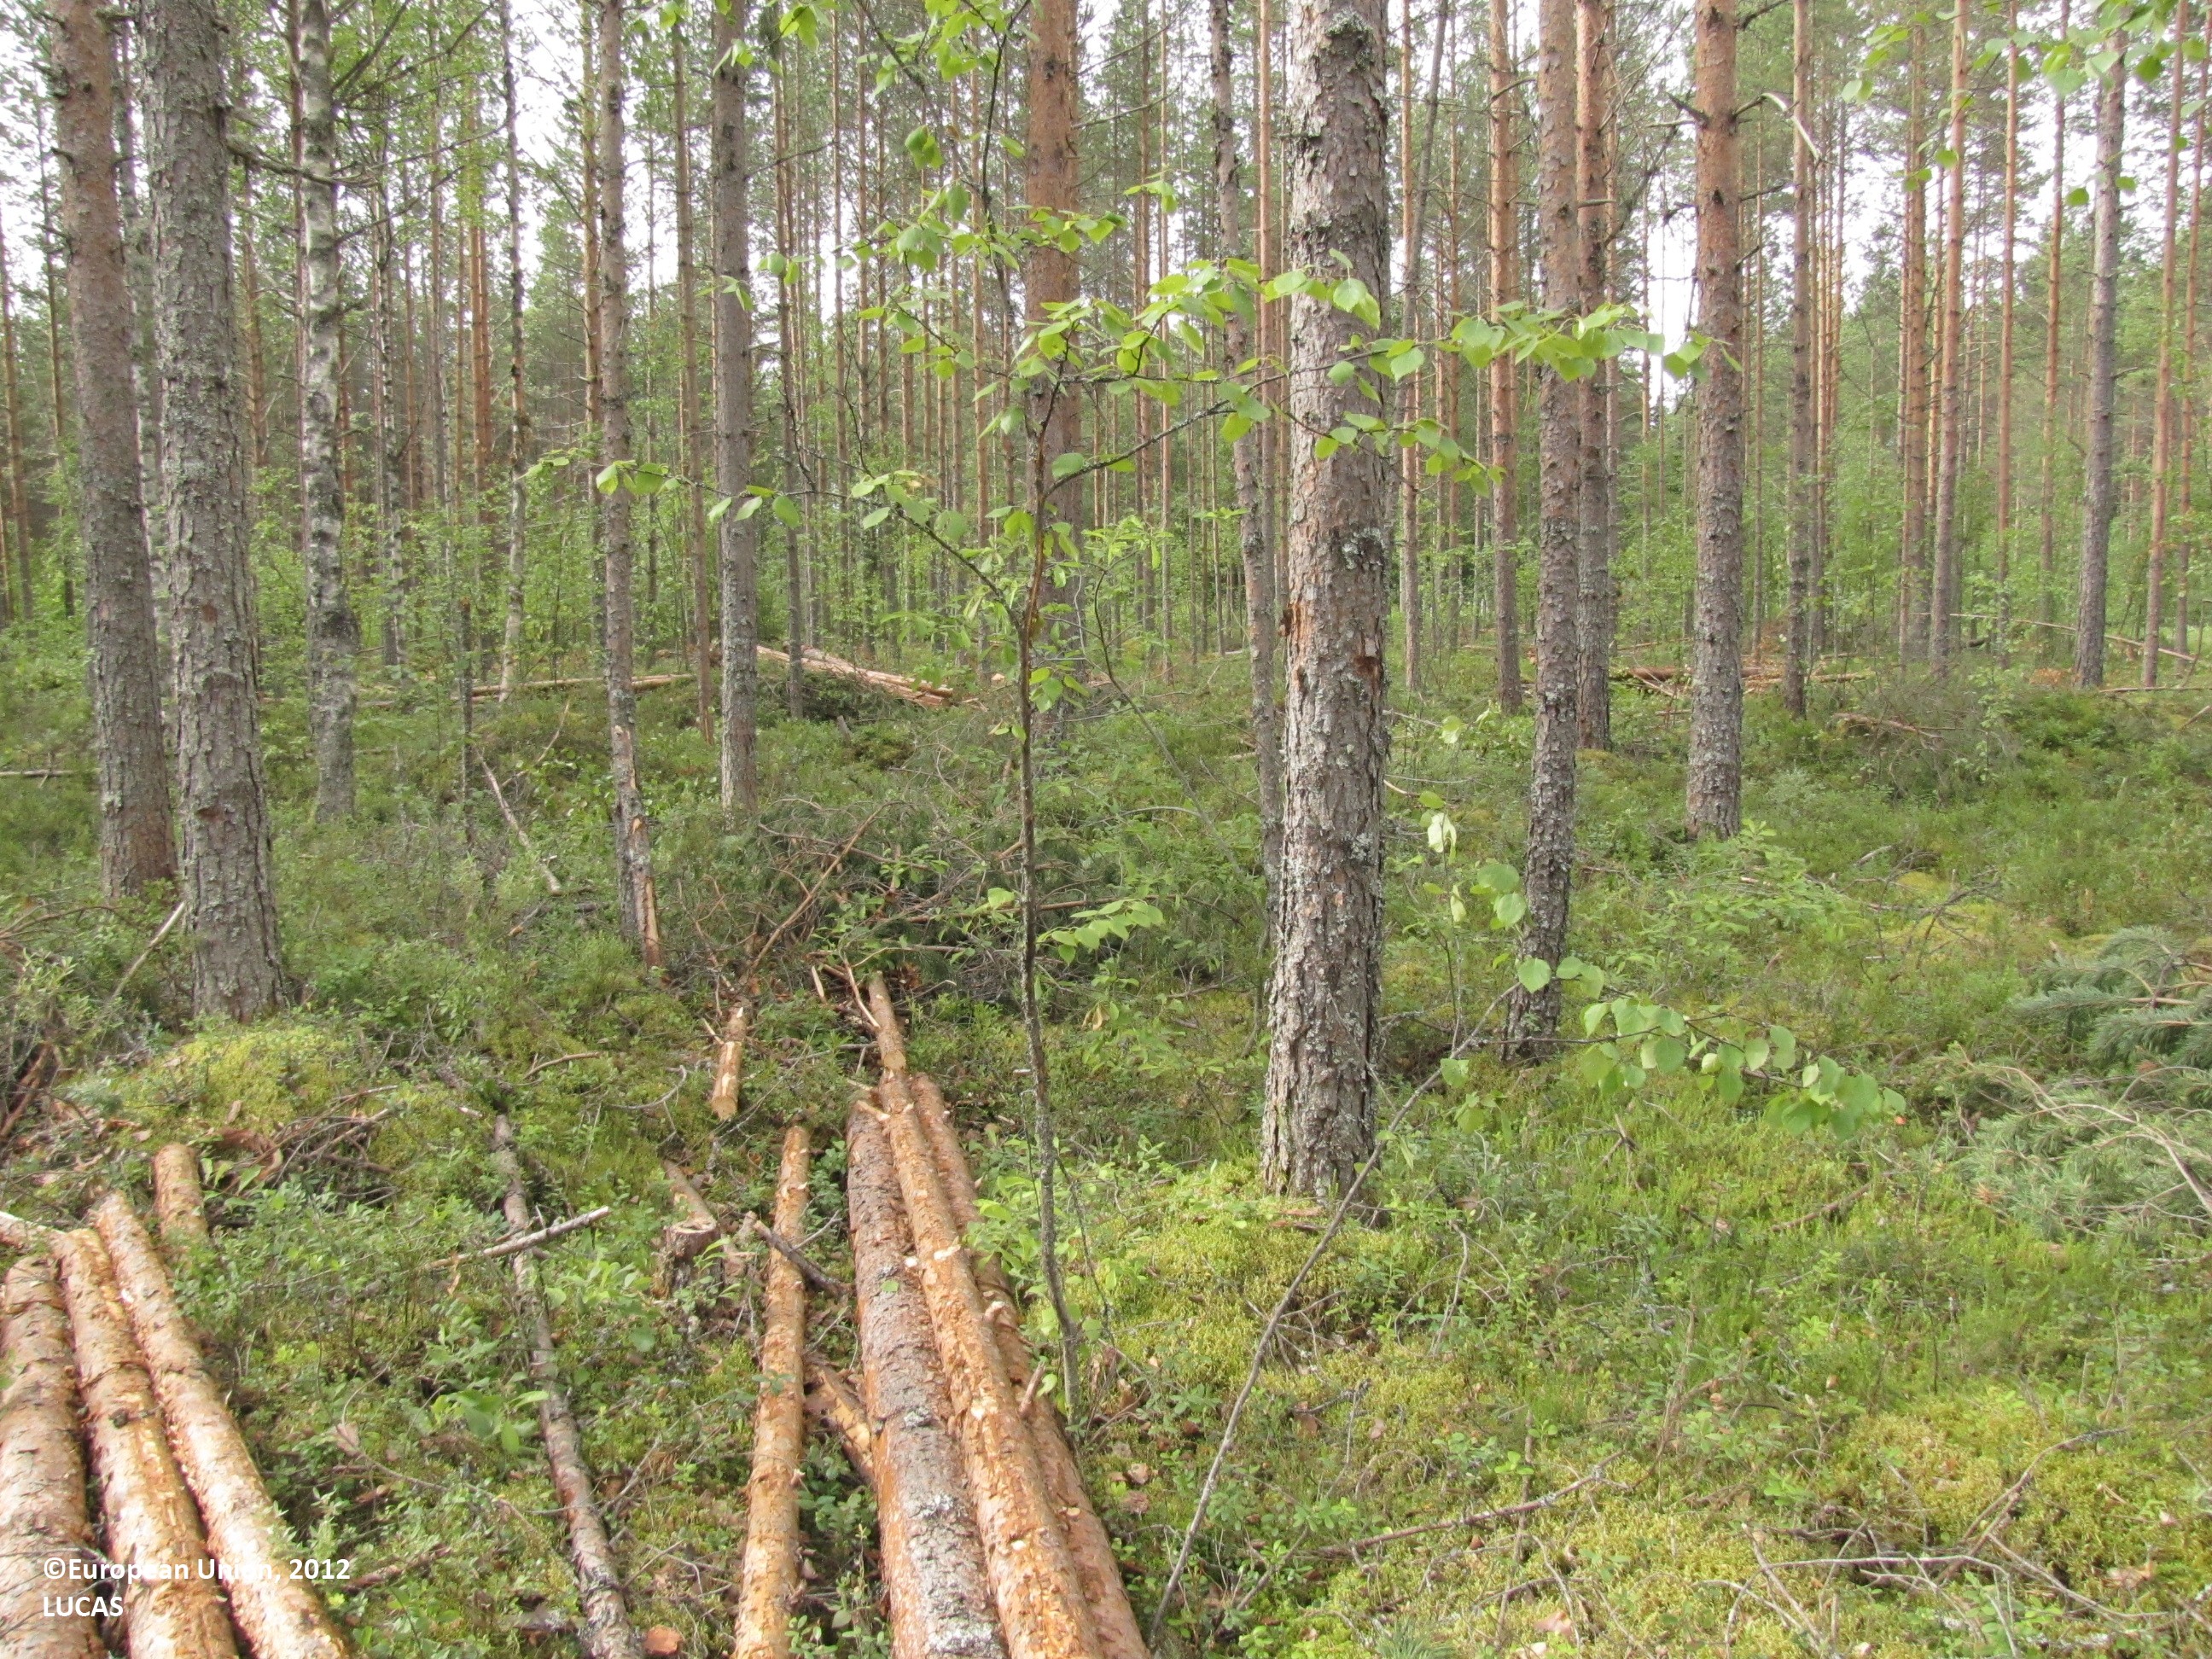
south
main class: Woodland
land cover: Pine dominated coniferous woodland
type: mire and swamp forests
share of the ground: 50 - 75 %
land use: Forestry
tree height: > 5 m
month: July
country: FI
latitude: 62.3700
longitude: 23.2698
